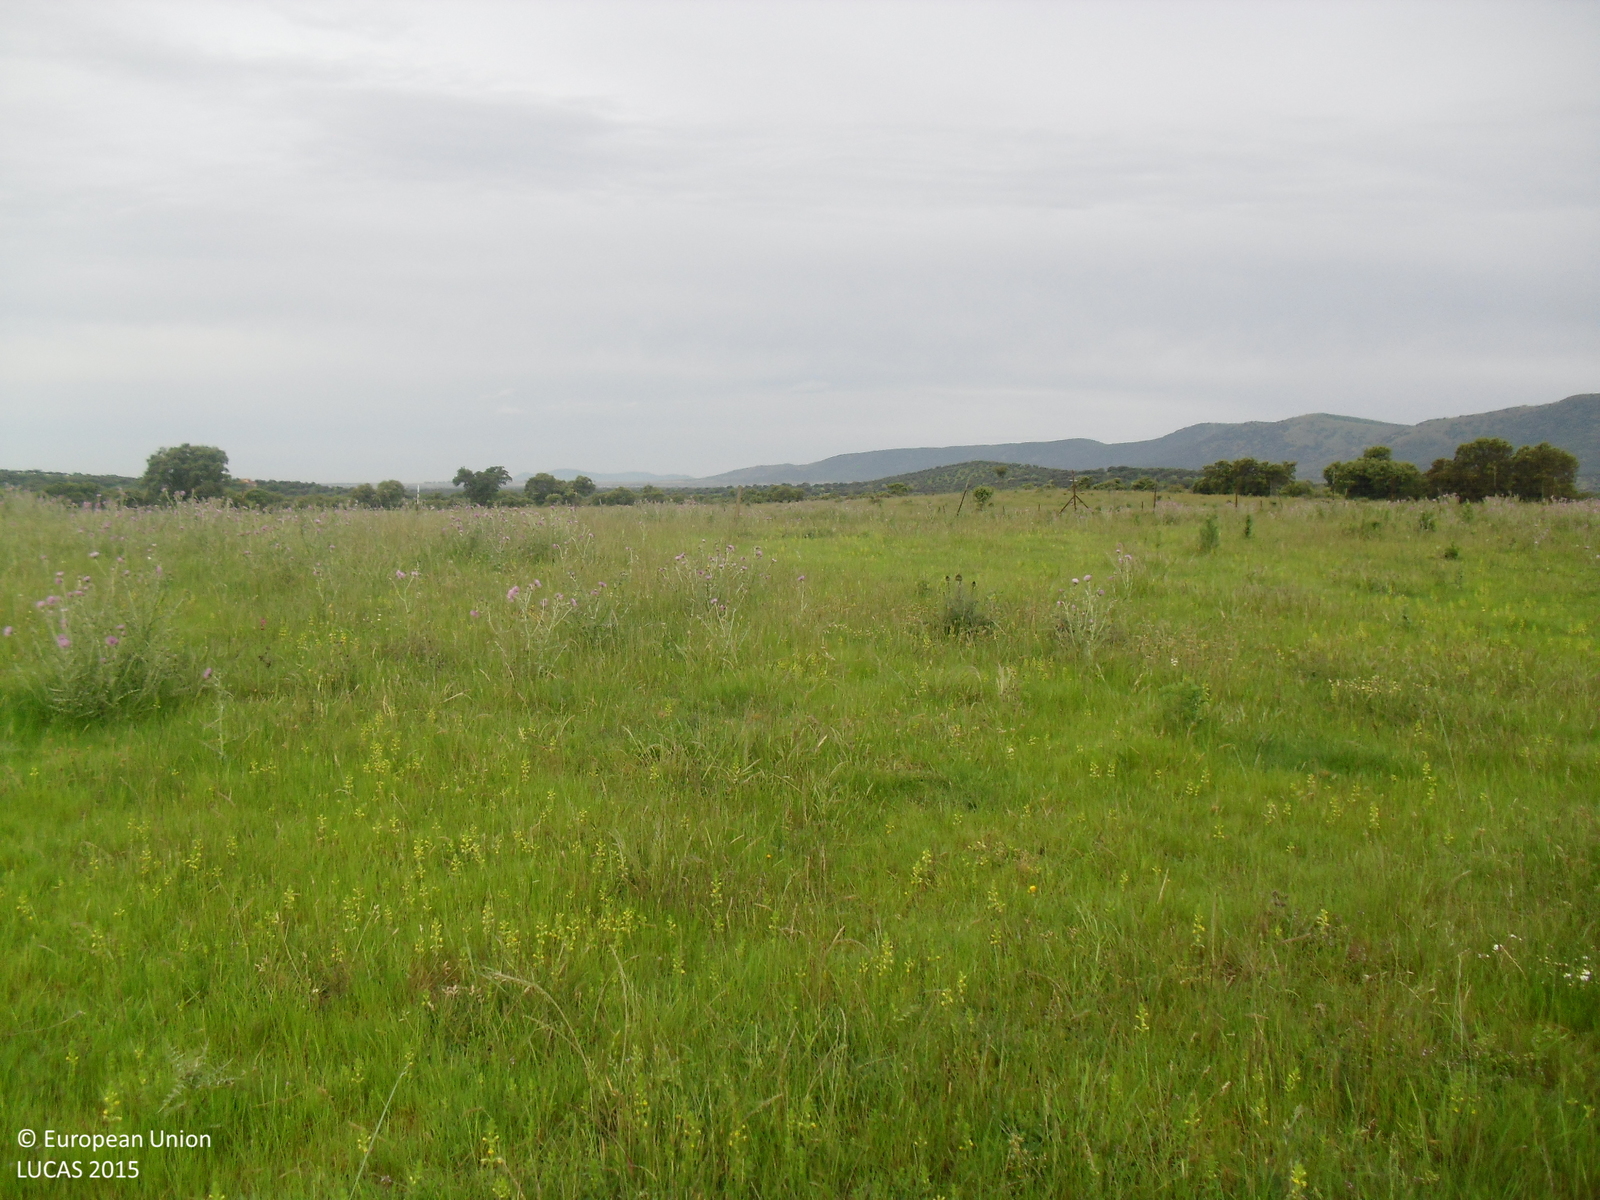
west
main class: Grassland
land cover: Grassland without tree/shrub cover
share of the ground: > 75 %
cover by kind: herbaceous plants 100 %
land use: Agriculture (excluding fallow land and kitchen gardens)
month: May
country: ES
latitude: 39.3336
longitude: -5.5377
